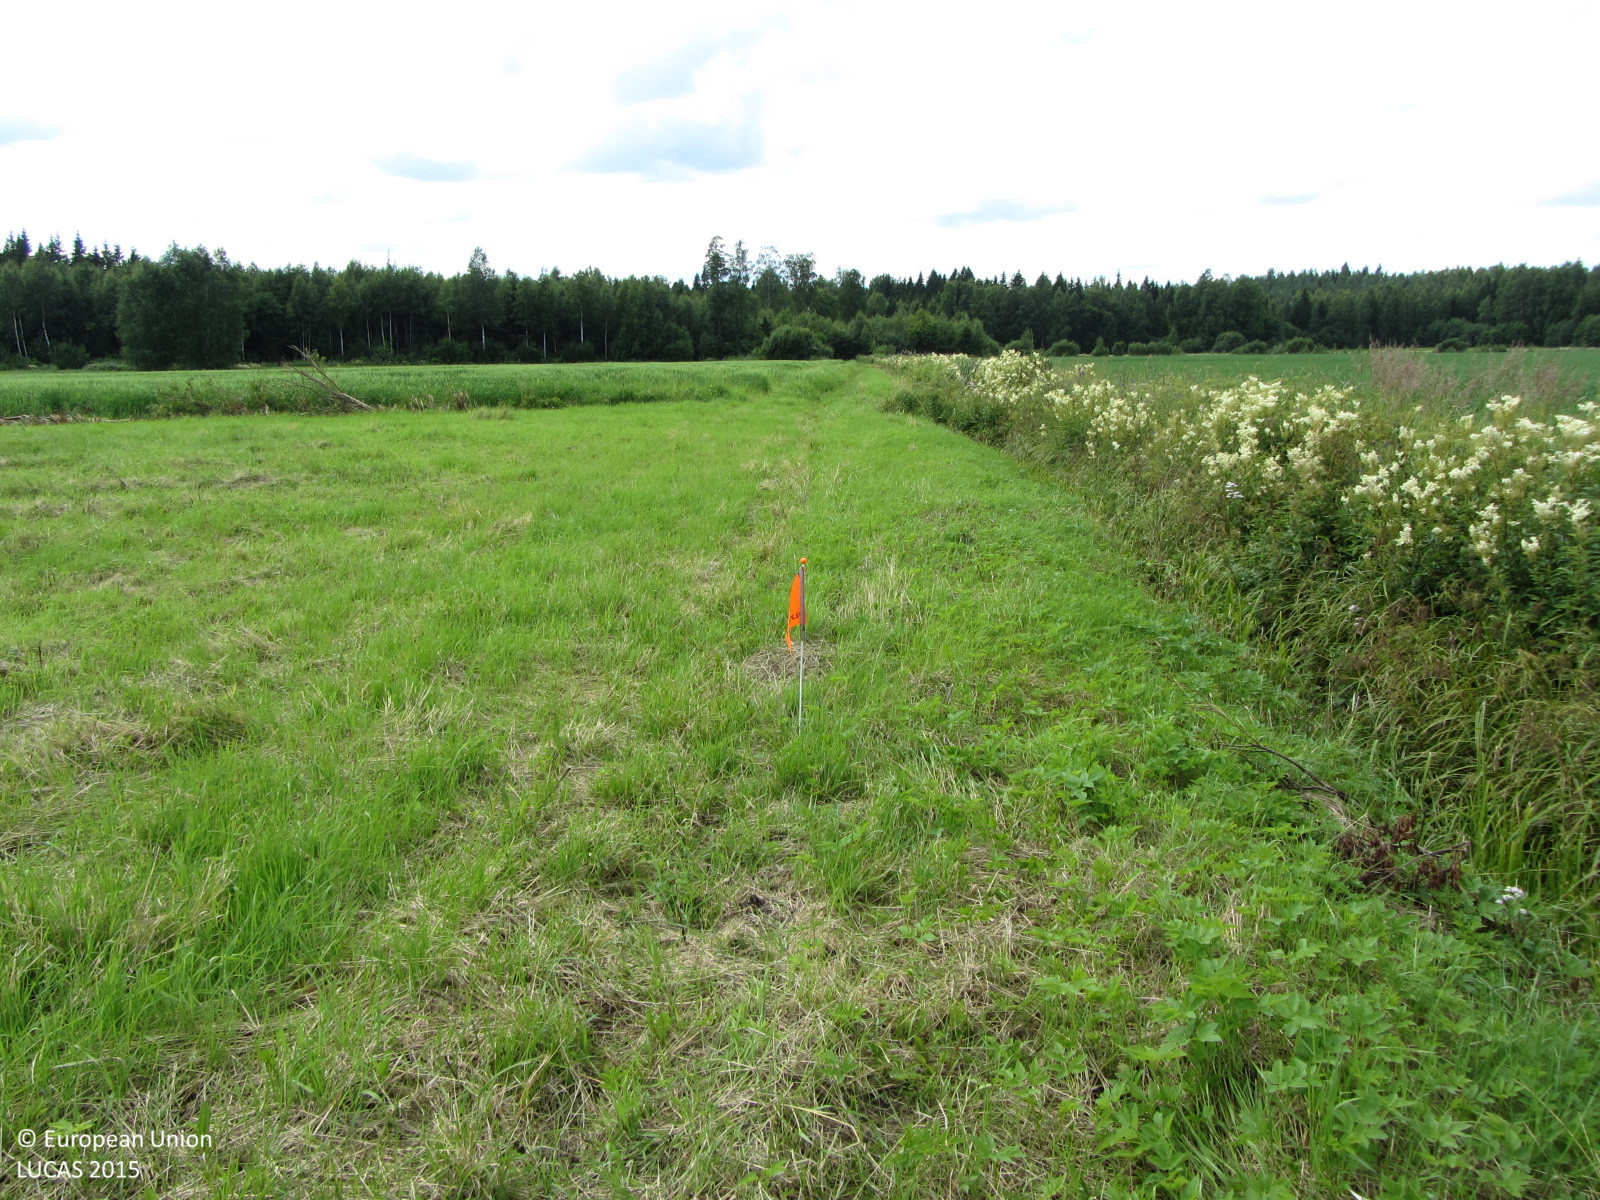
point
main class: Grassland
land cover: Grassland without tree/shrub cover
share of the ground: > 75 %
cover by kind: herbaceous plants 100 %
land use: Agriculture (excluding fallow land and kitchen gardens)
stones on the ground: < 10 %
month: July
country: FI
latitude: 60.7080
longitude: 24.5255
